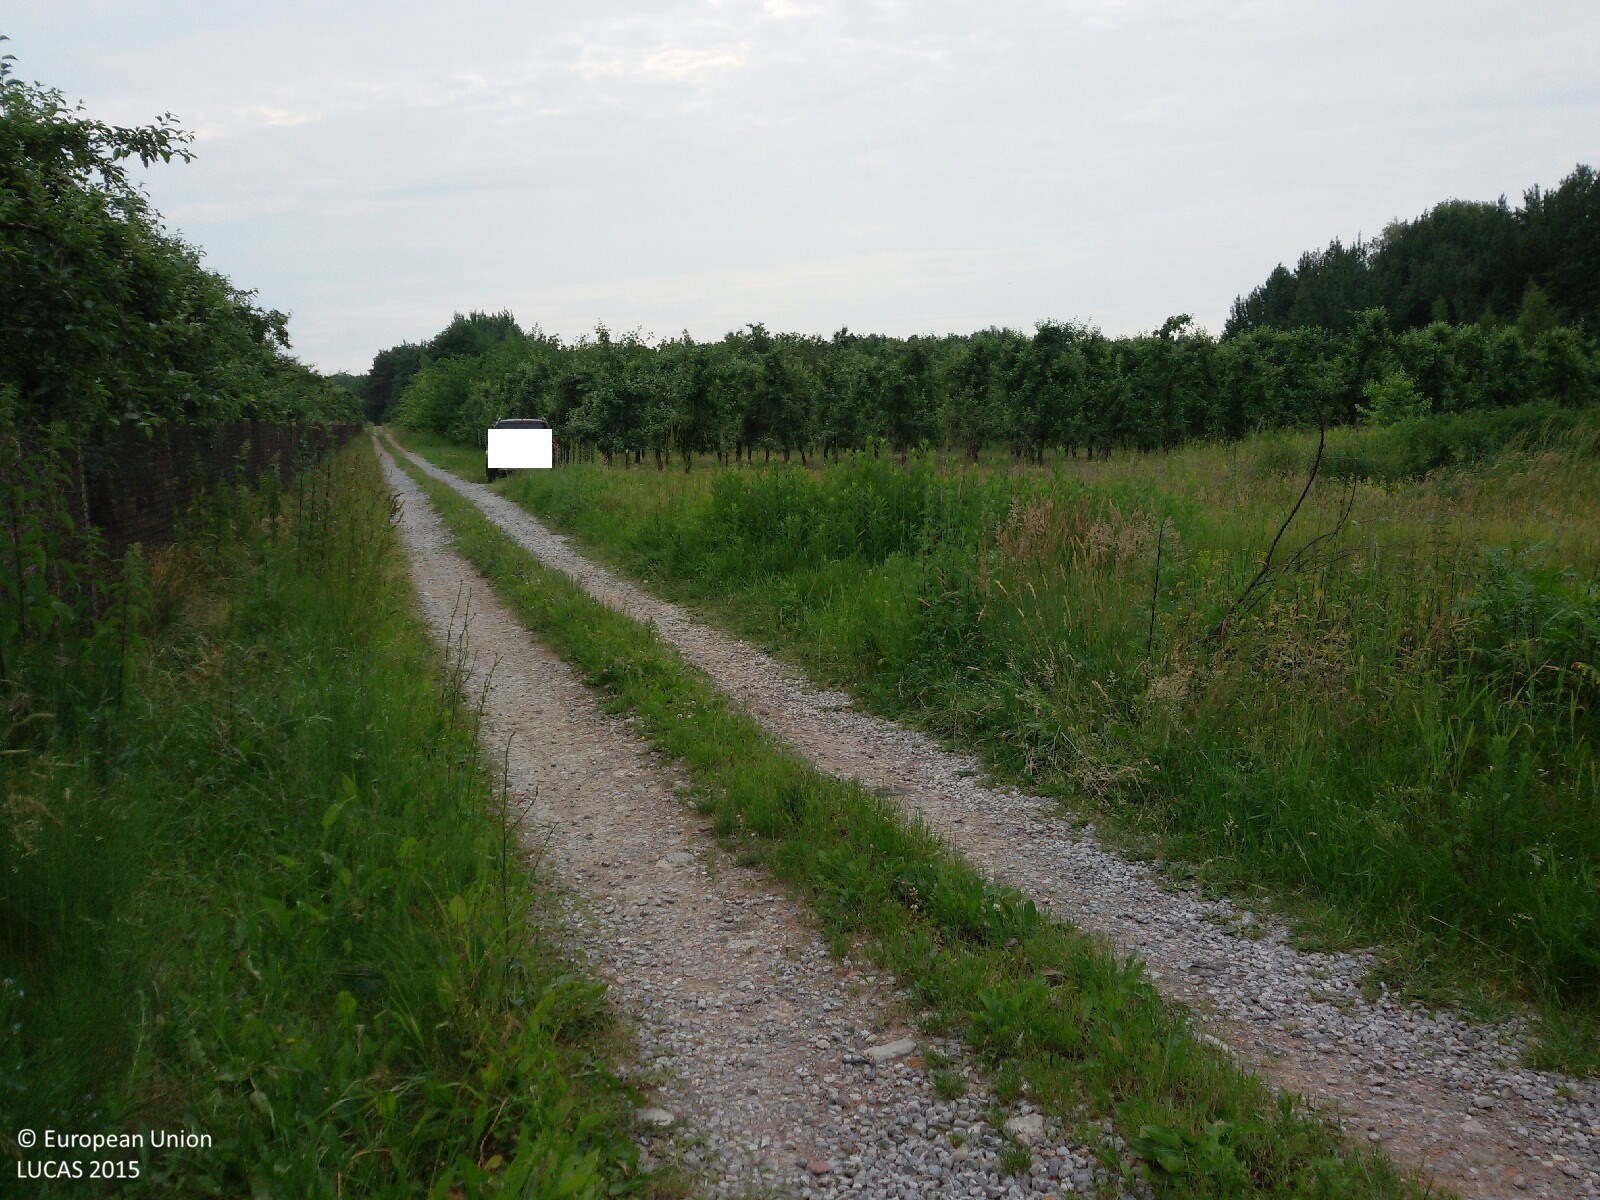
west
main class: Cropland
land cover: Apple fruit
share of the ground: > 75 %
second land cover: Grassland without tree/shrub cover
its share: 50 - 75 %
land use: Agriculture (excluding fallow land and kitchen gardens)
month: June
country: PL
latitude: 51.9361
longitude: 21.2031
